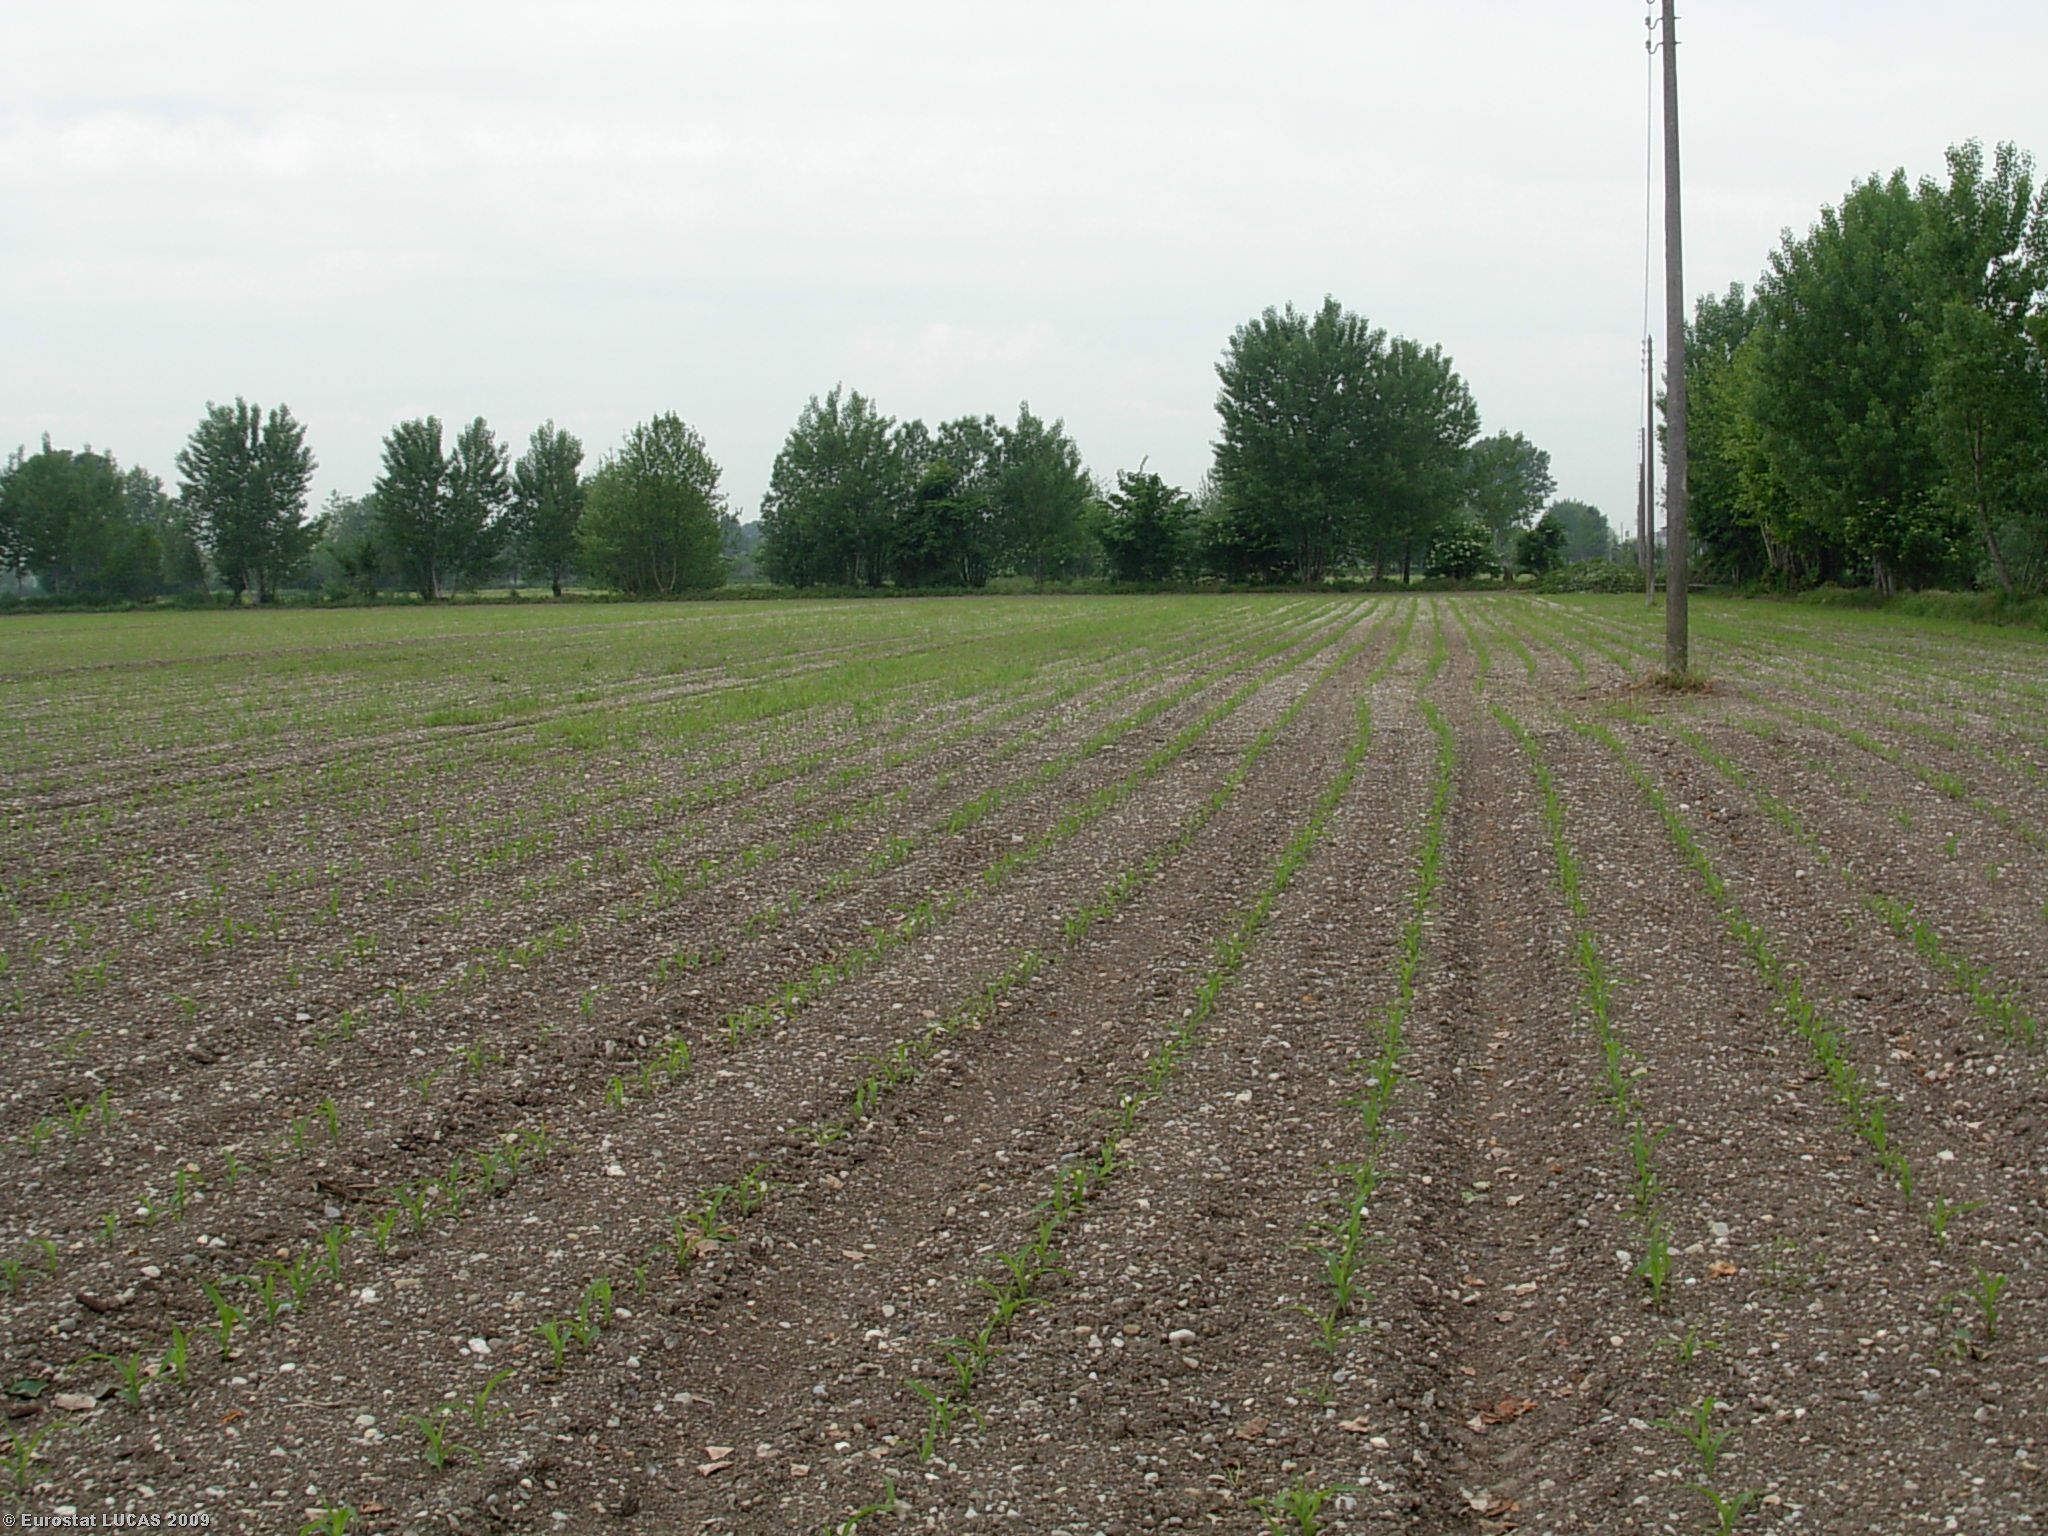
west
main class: Cropland
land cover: Maize
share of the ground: < 10 %
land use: Agriculture (excluding fallow land and kitchen gardens)
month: May
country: IT
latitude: 45.3417
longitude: 10.3185
